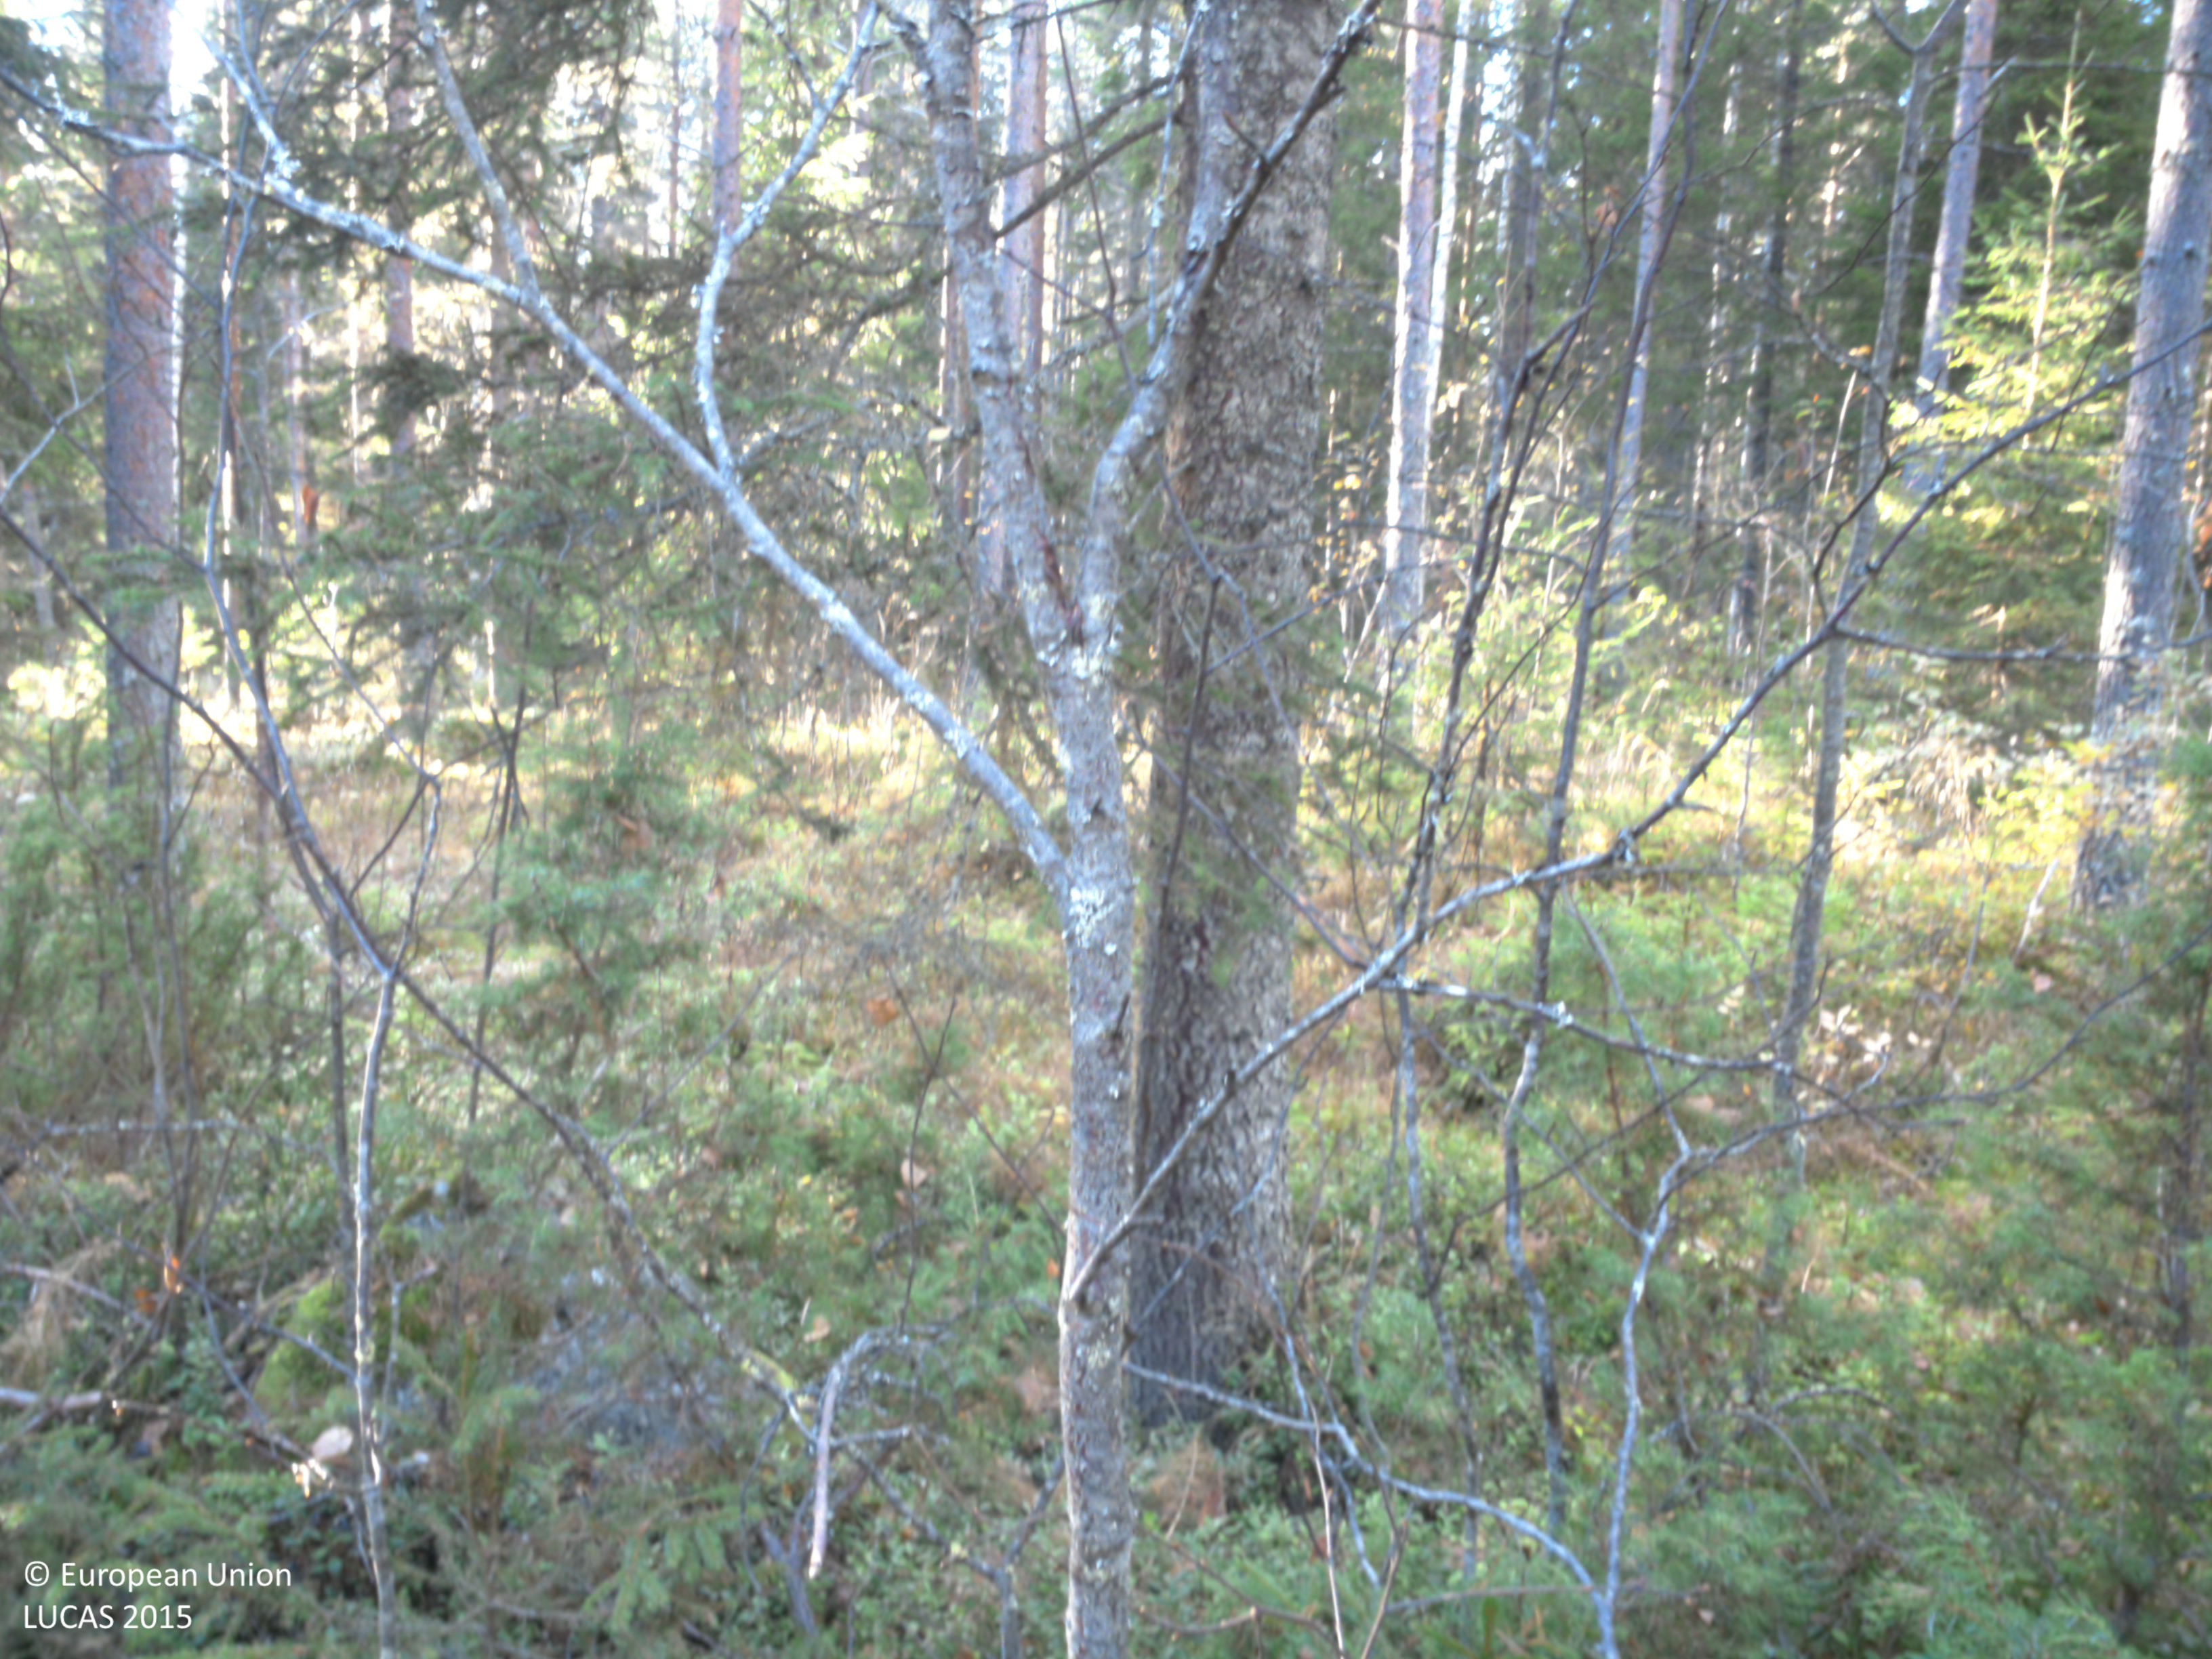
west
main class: Woodland
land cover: Other coniferous woodland
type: boreal forest
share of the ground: > 75 %
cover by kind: coniferous forest trees 80 %, shrubs 10 %, herbaceous plants 5 %, lichens and mosses 5 %
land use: Forestry
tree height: > 5 m
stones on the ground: 25 - 50 %
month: October
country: SE
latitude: 63.8747
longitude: 18.5835
